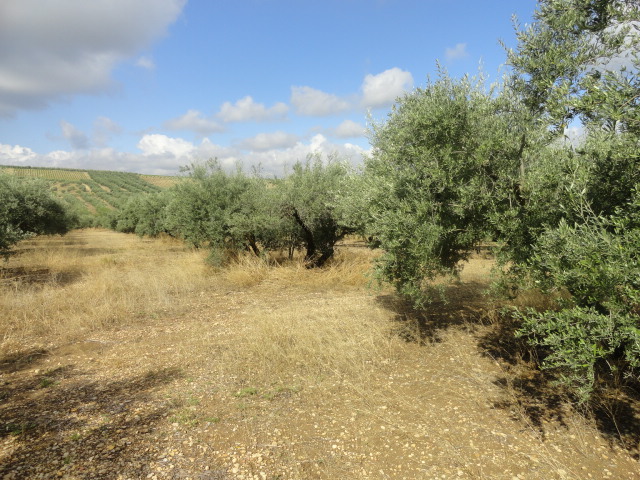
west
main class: Cropland
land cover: Olive groves
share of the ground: 50 - 75 %
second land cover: Spontaneously vegetated surfaces
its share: 10 - 25 %
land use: Agriculture (excluding fallow land and kitchen gardens)
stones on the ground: > 50 %
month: April
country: ES
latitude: 37.6093
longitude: -4.5865
